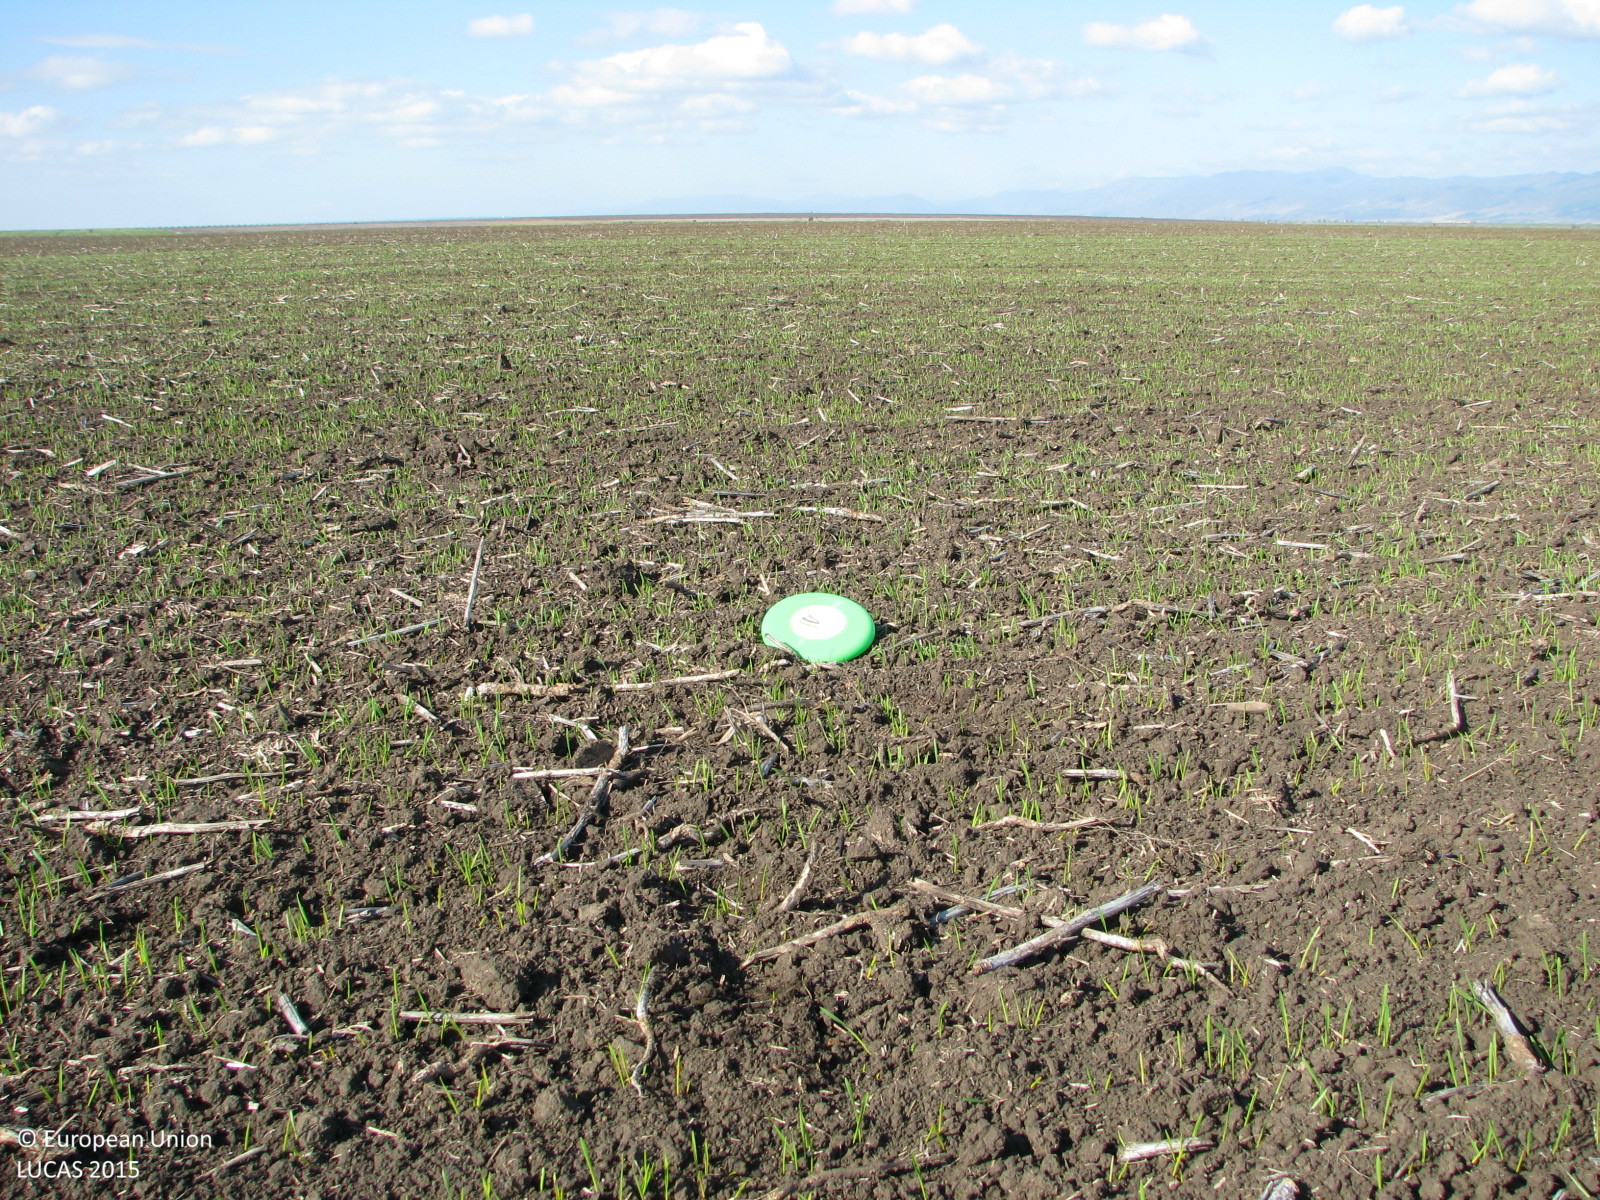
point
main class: Cropland
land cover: Common wheat
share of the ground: 10 - 25 %
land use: Agriculture (excluding fallow land and kitchen gardens)
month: November
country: BG
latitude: 42.5664
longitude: 26.6764
